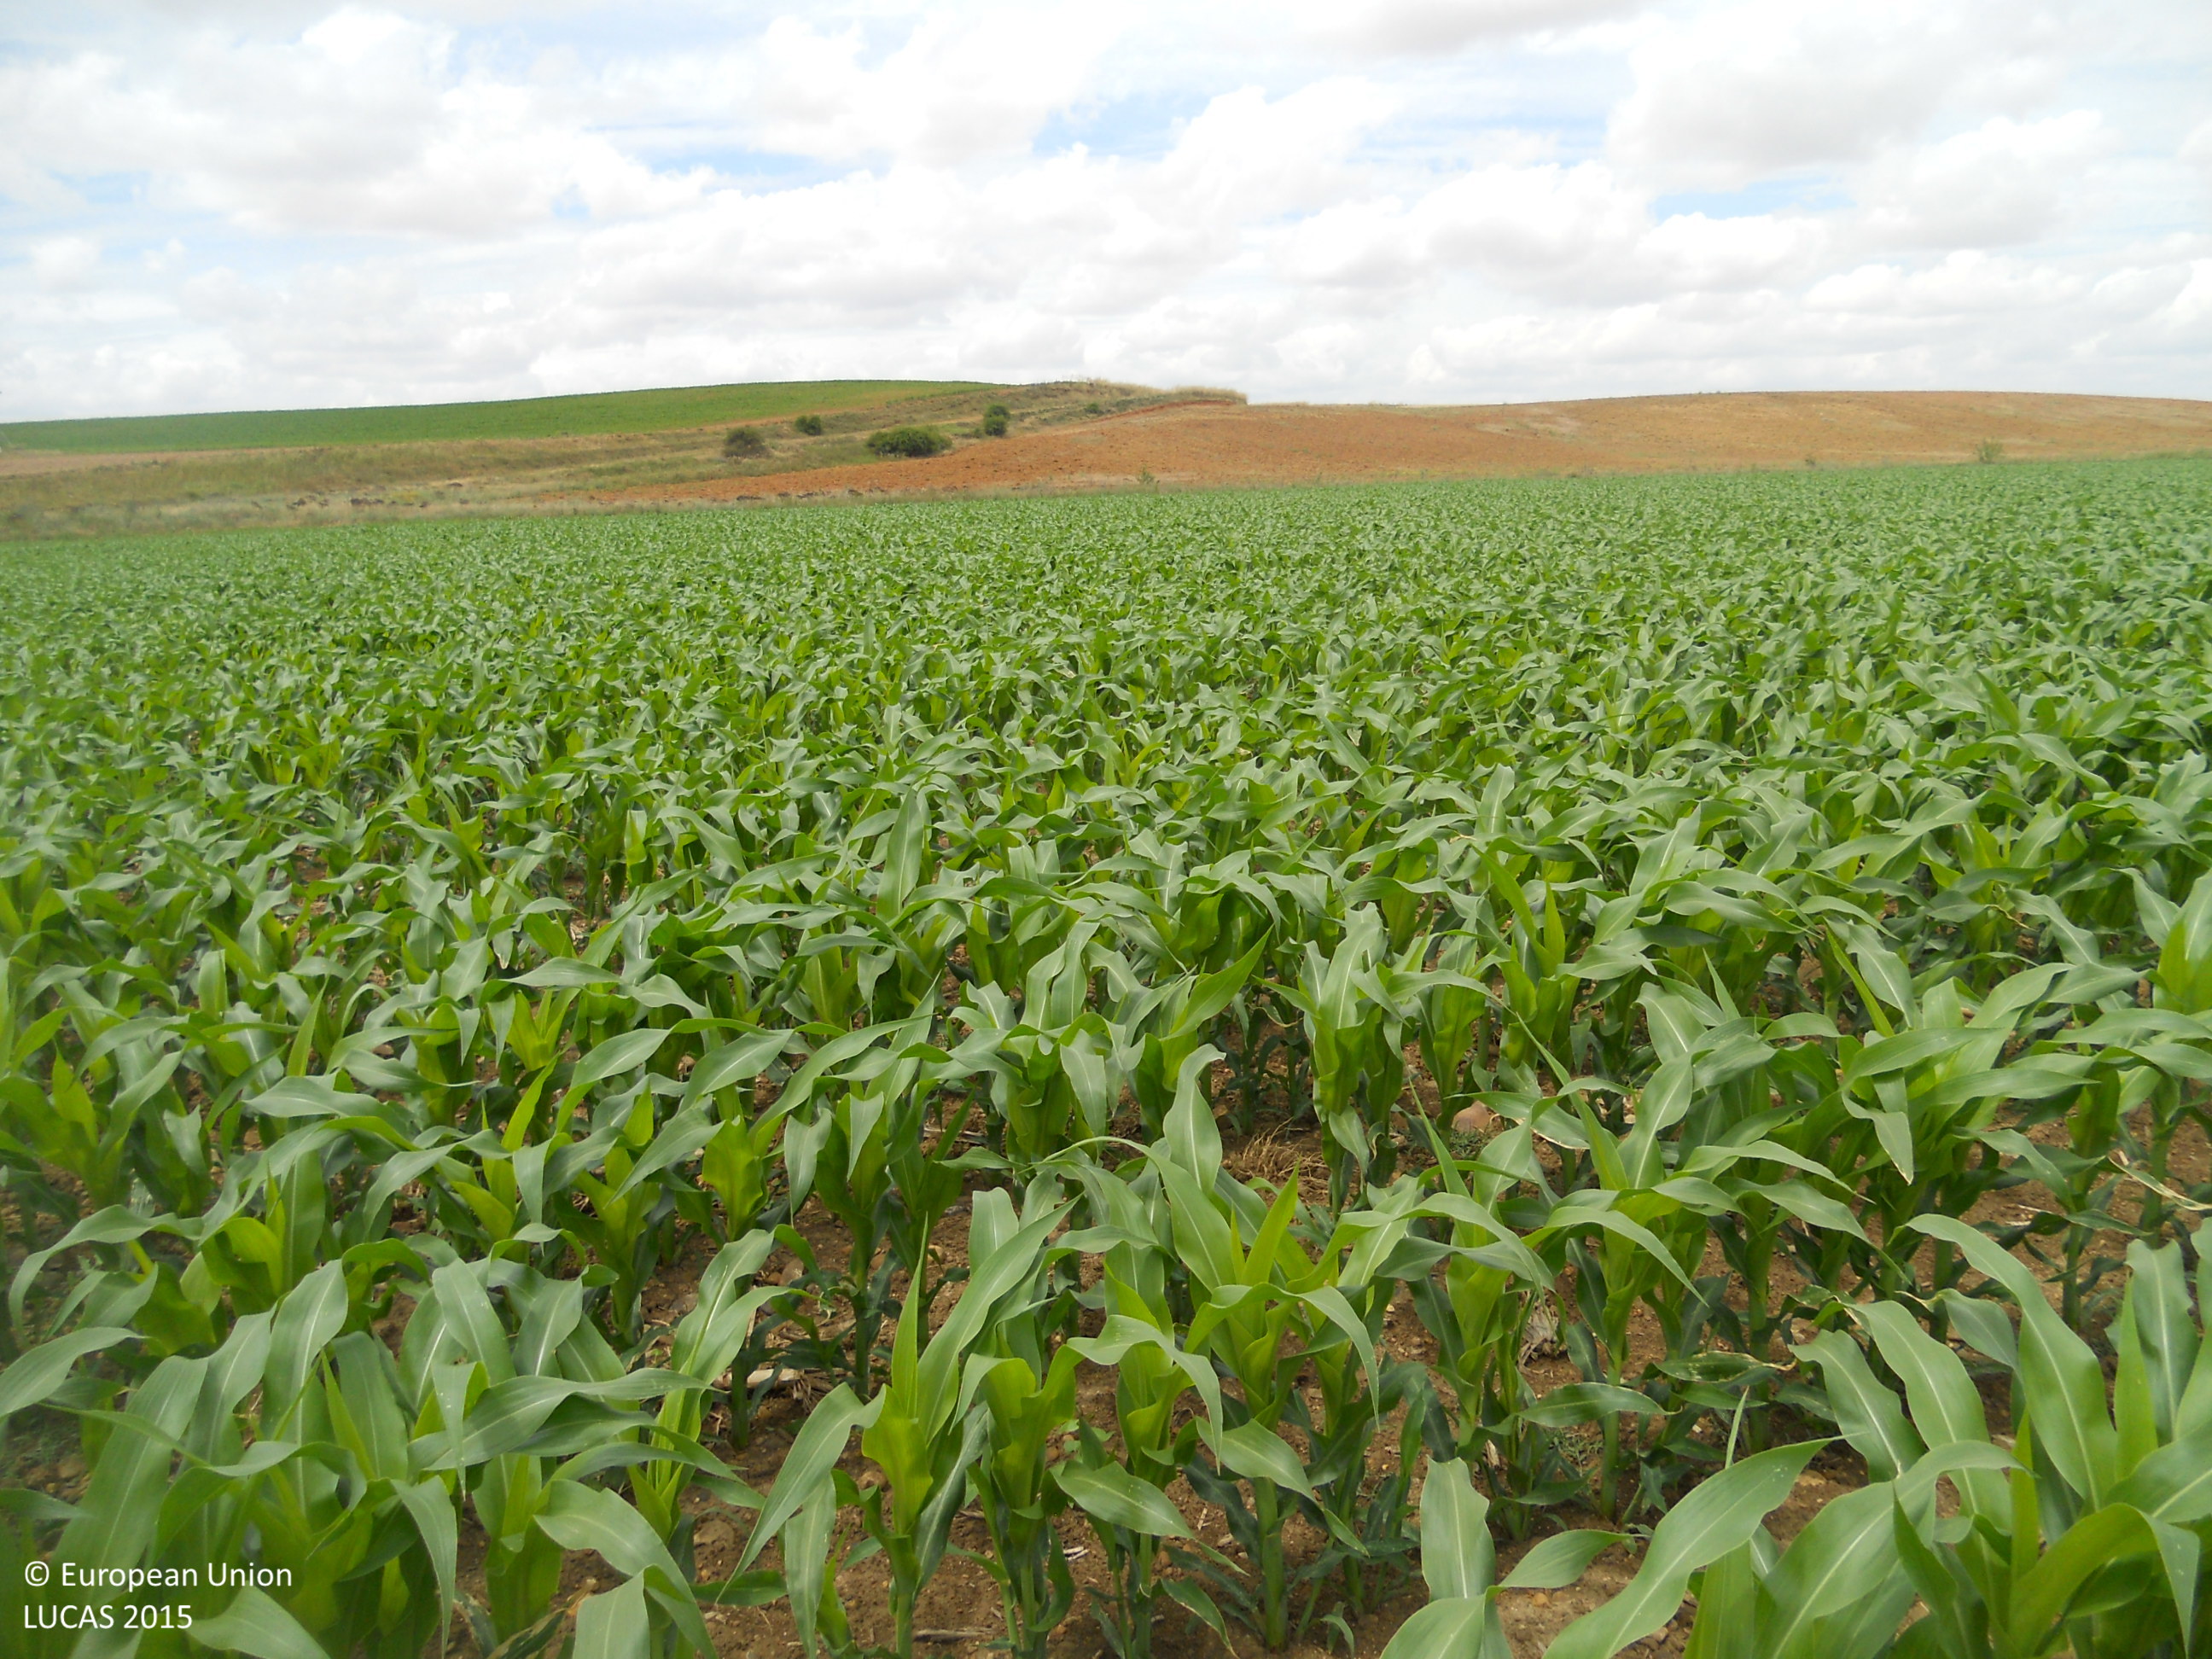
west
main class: Cropland
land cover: Maize
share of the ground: > 75 %
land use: Agriculture (excluding fallow land and kitchen gardens)
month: June
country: ES
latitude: 42.2969
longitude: -5.2610
